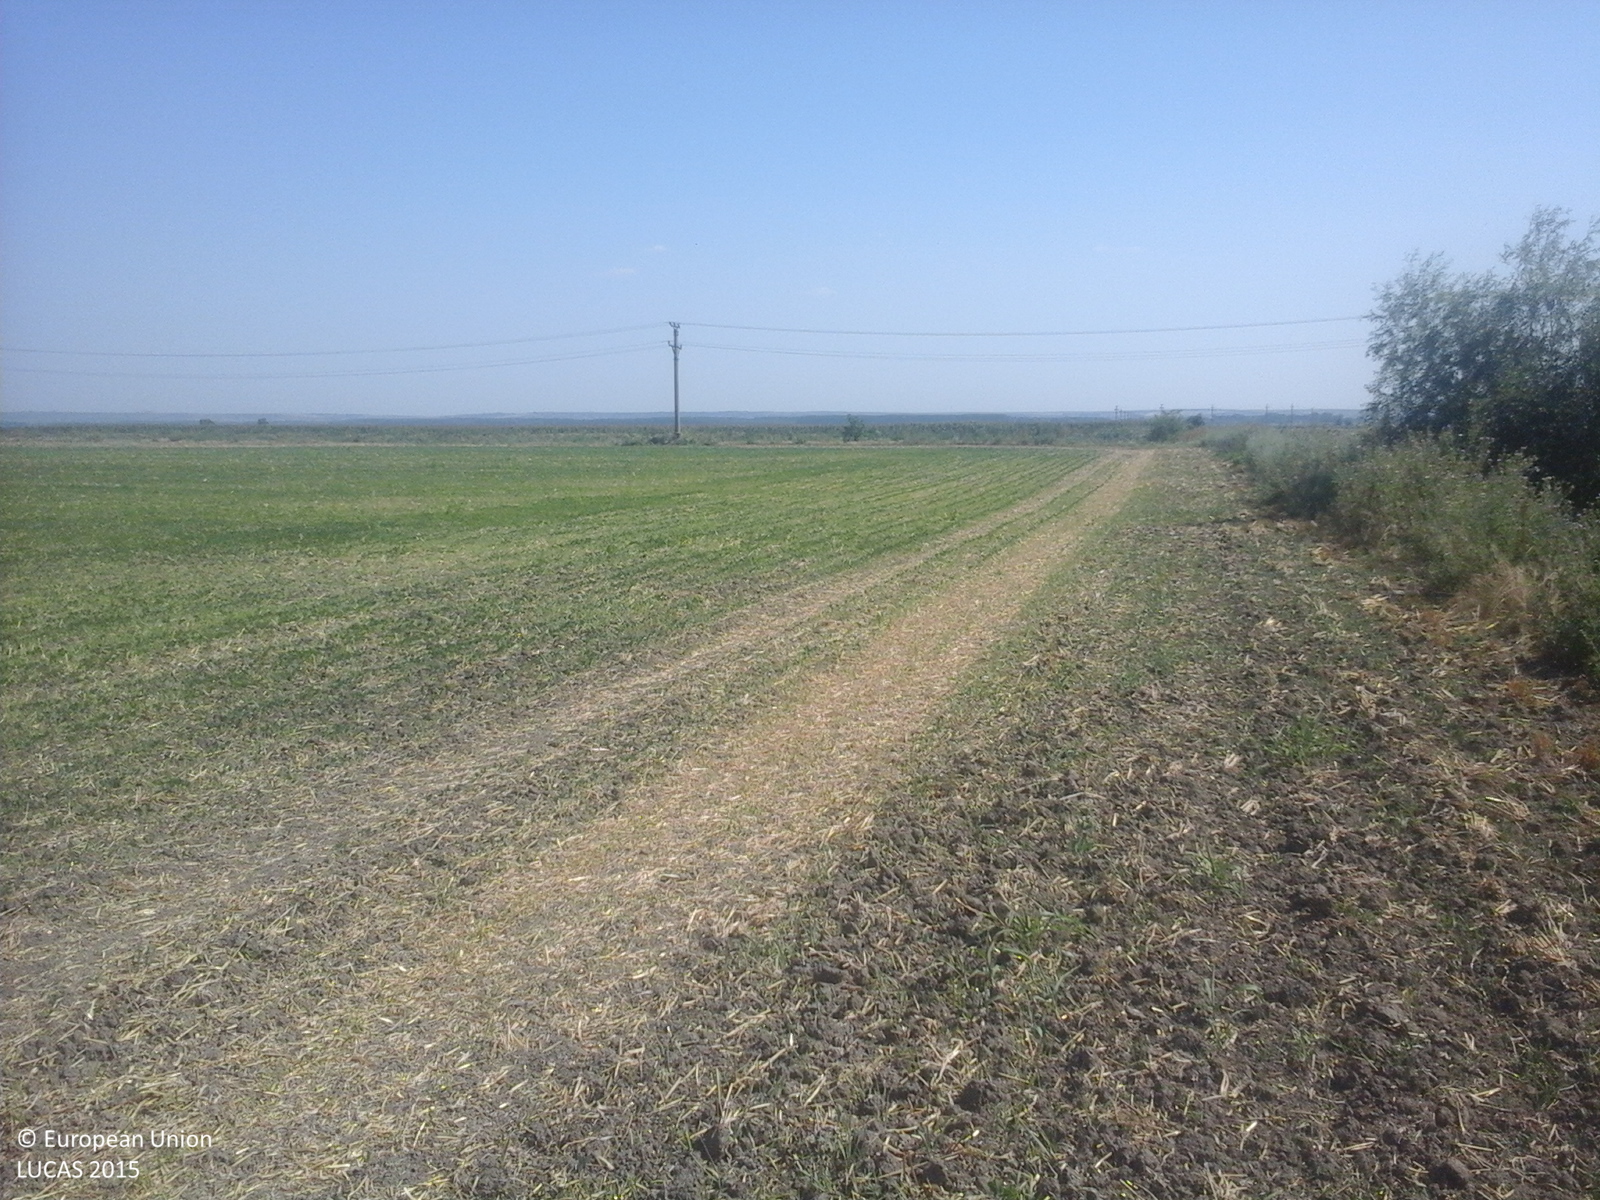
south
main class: Cropland
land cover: Soya
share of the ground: < 10 %
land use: Agriculture (excluding fallow land and kitchen gardens)
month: July
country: RO
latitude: 44.1833
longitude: 27.1292
